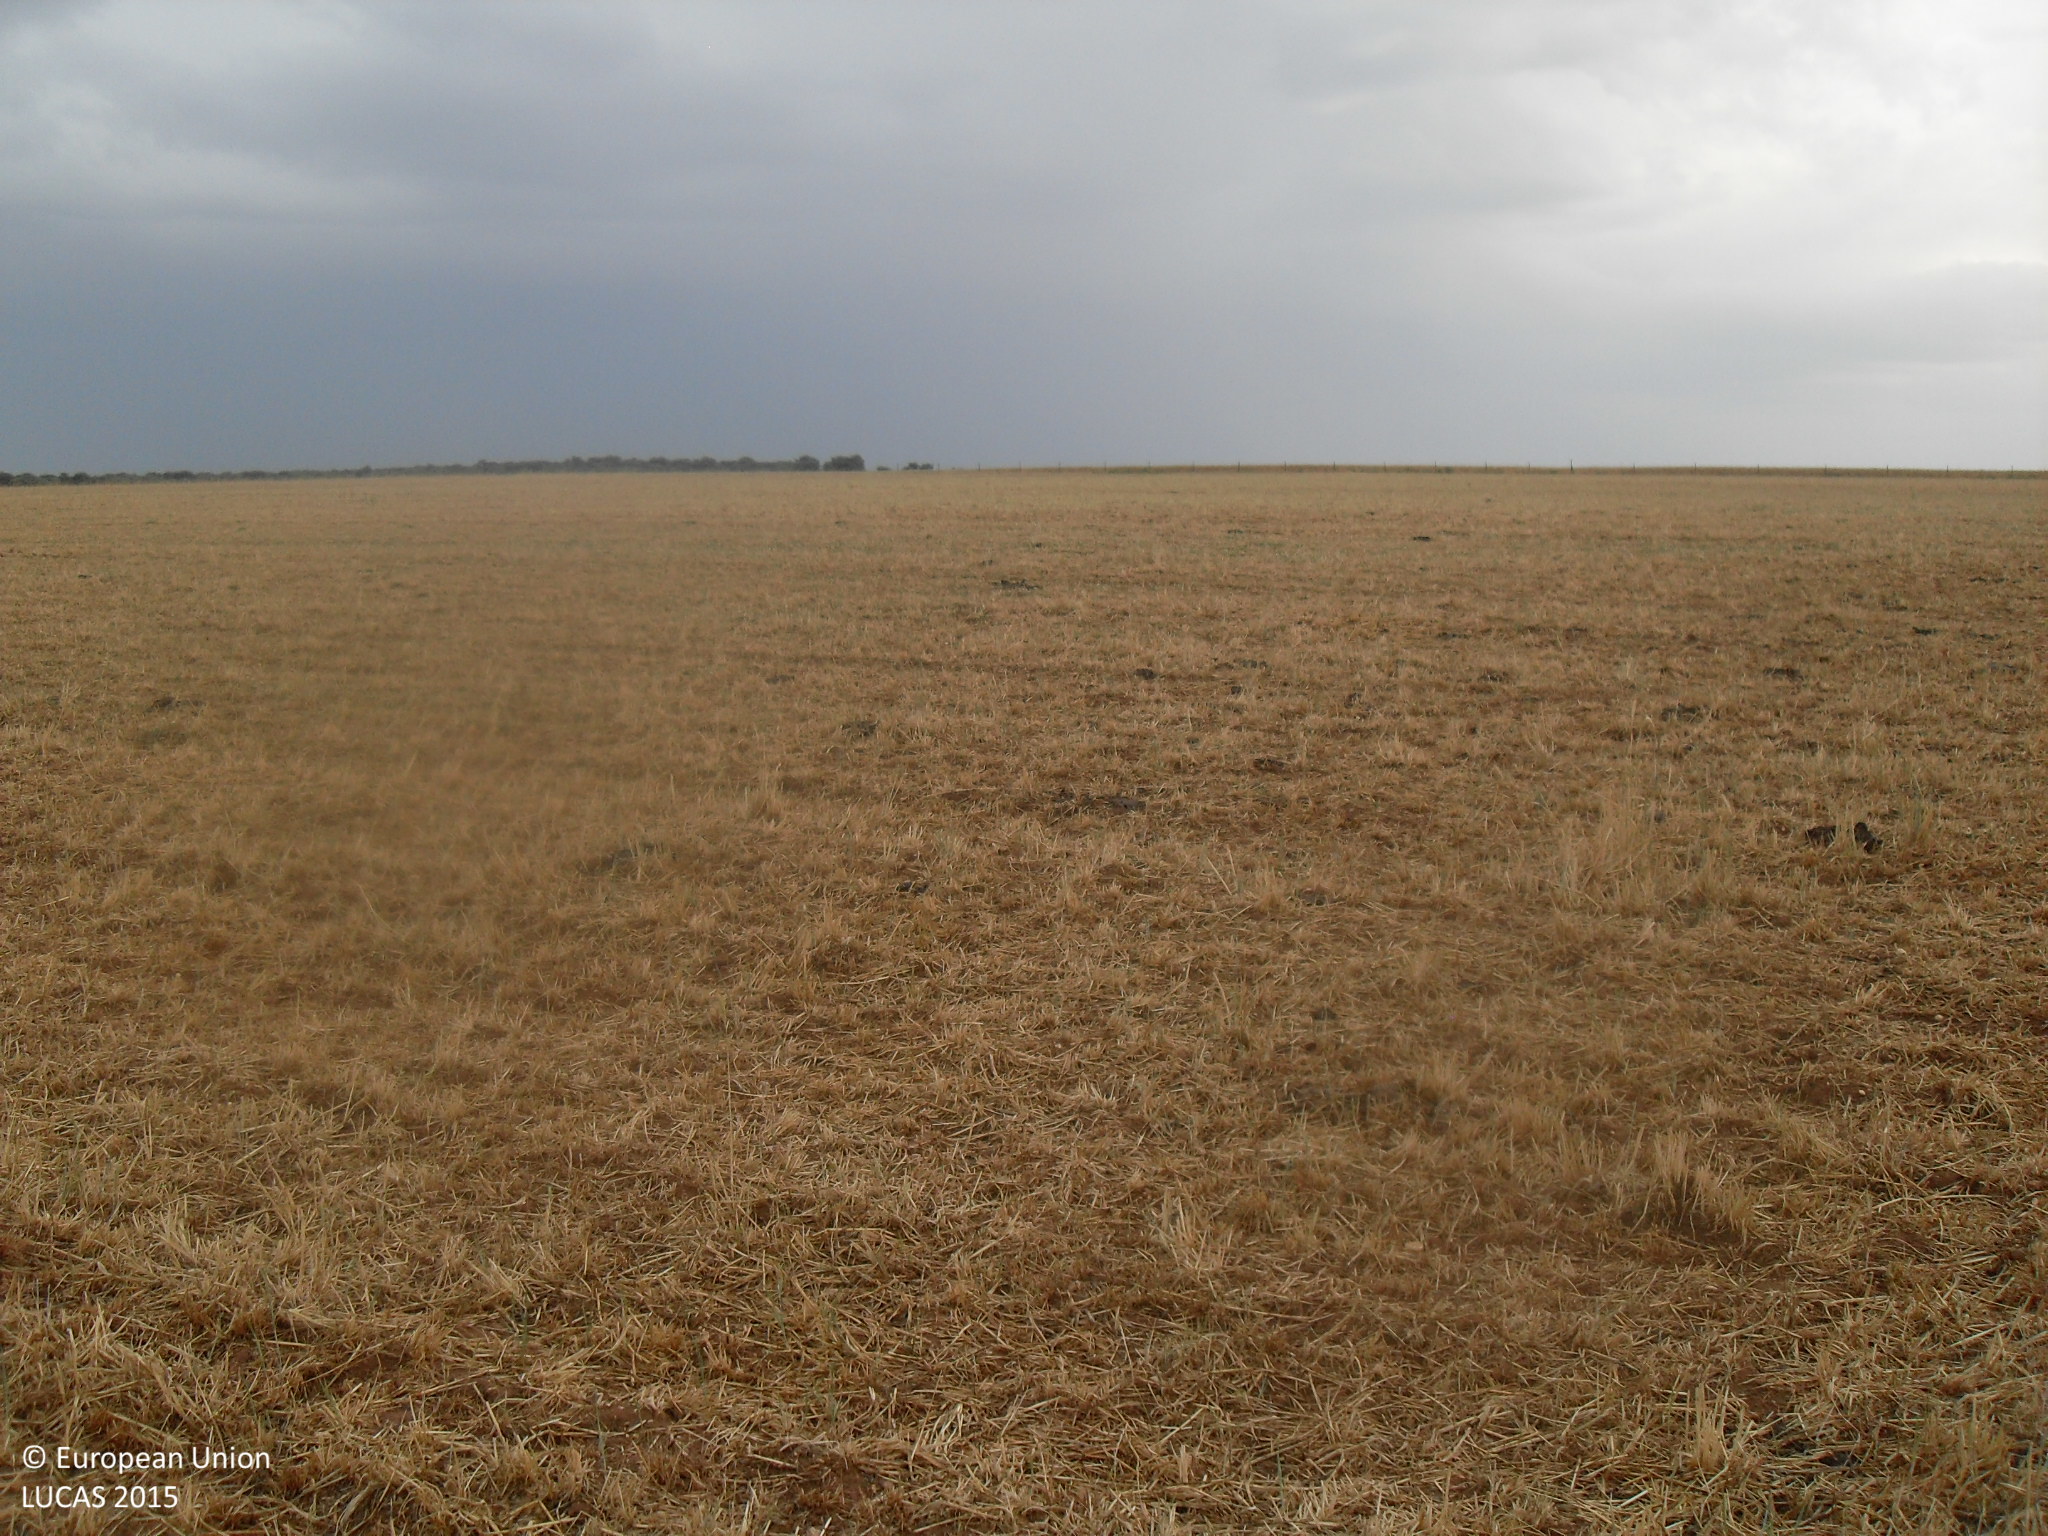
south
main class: Cropland
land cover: Rye
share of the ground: 10 - 25 %
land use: Agriculture (excluding fallow land and kitchen gardens)
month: June
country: ES
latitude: 41.0494
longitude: -5.7247
